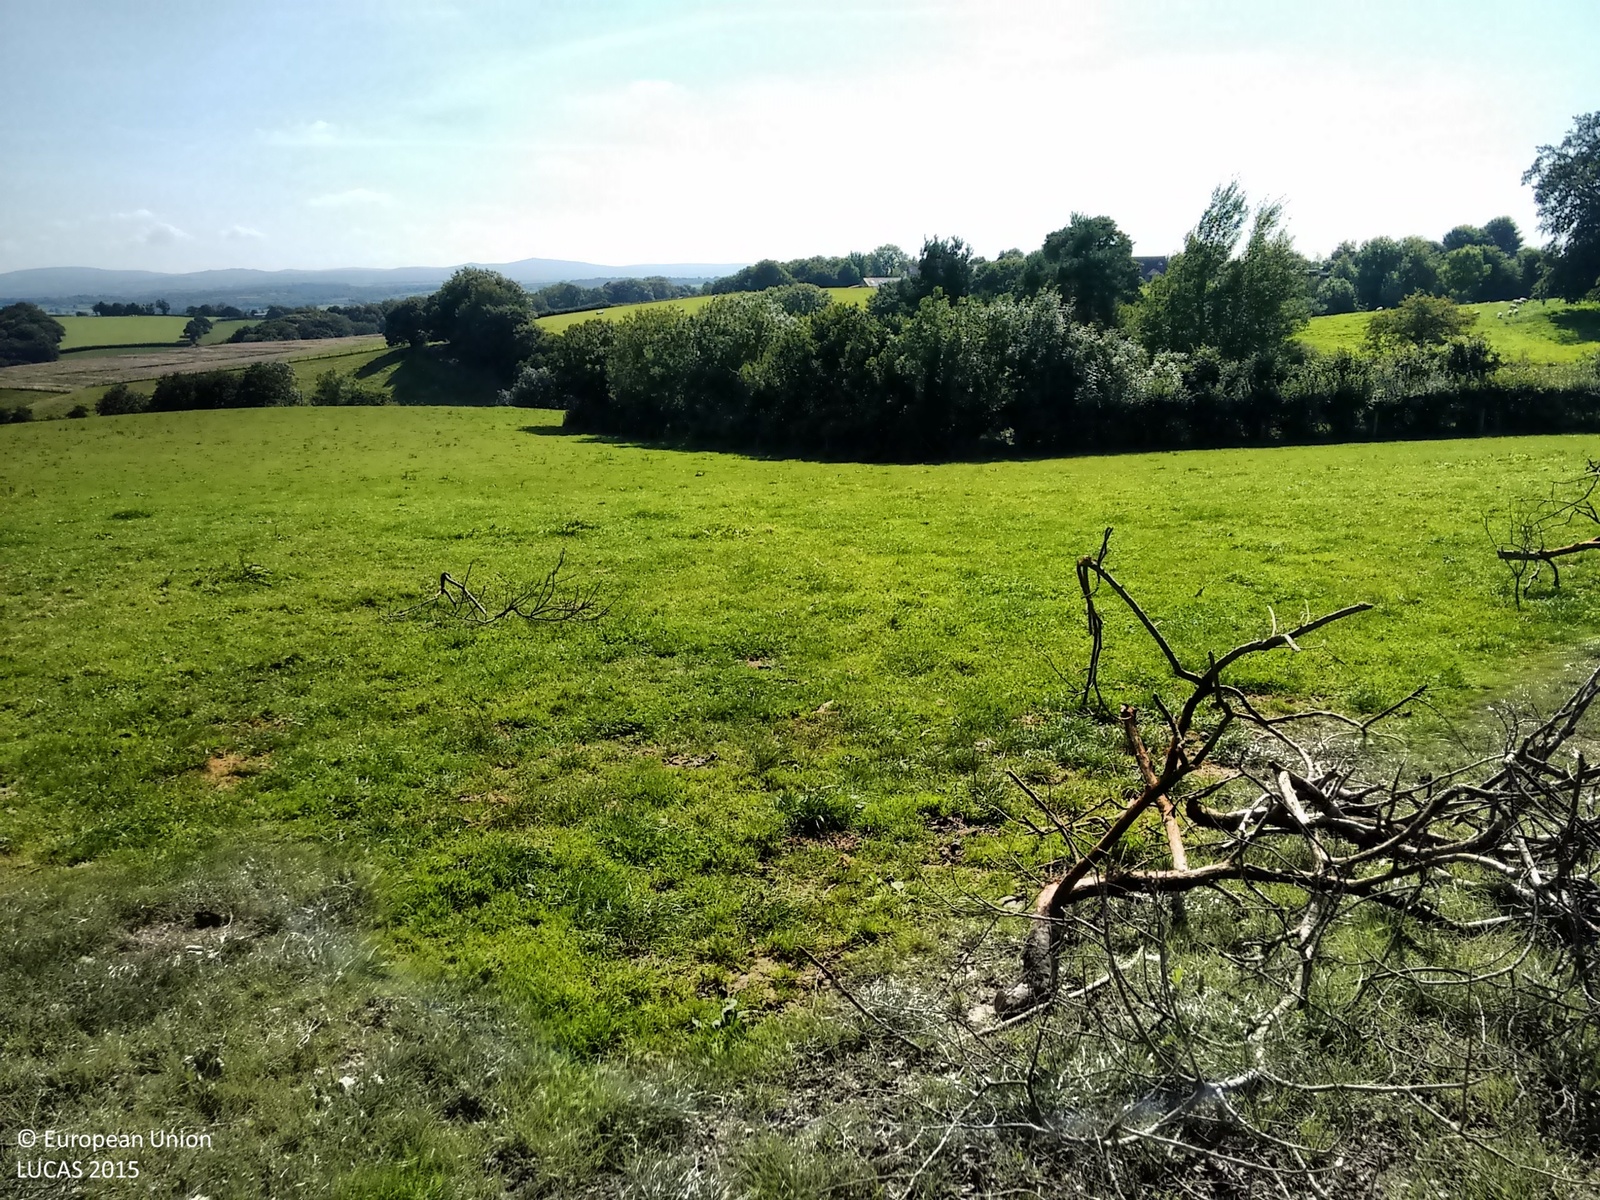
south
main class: Woodland
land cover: Broadleaved woodland
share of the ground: > 75 %
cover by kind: broadleaved forest trees 100 %
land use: Agriculture (excluding fallow land and kitchen gardens)
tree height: > 5 m
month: September
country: GB
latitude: 50.8593
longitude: -4.0605
